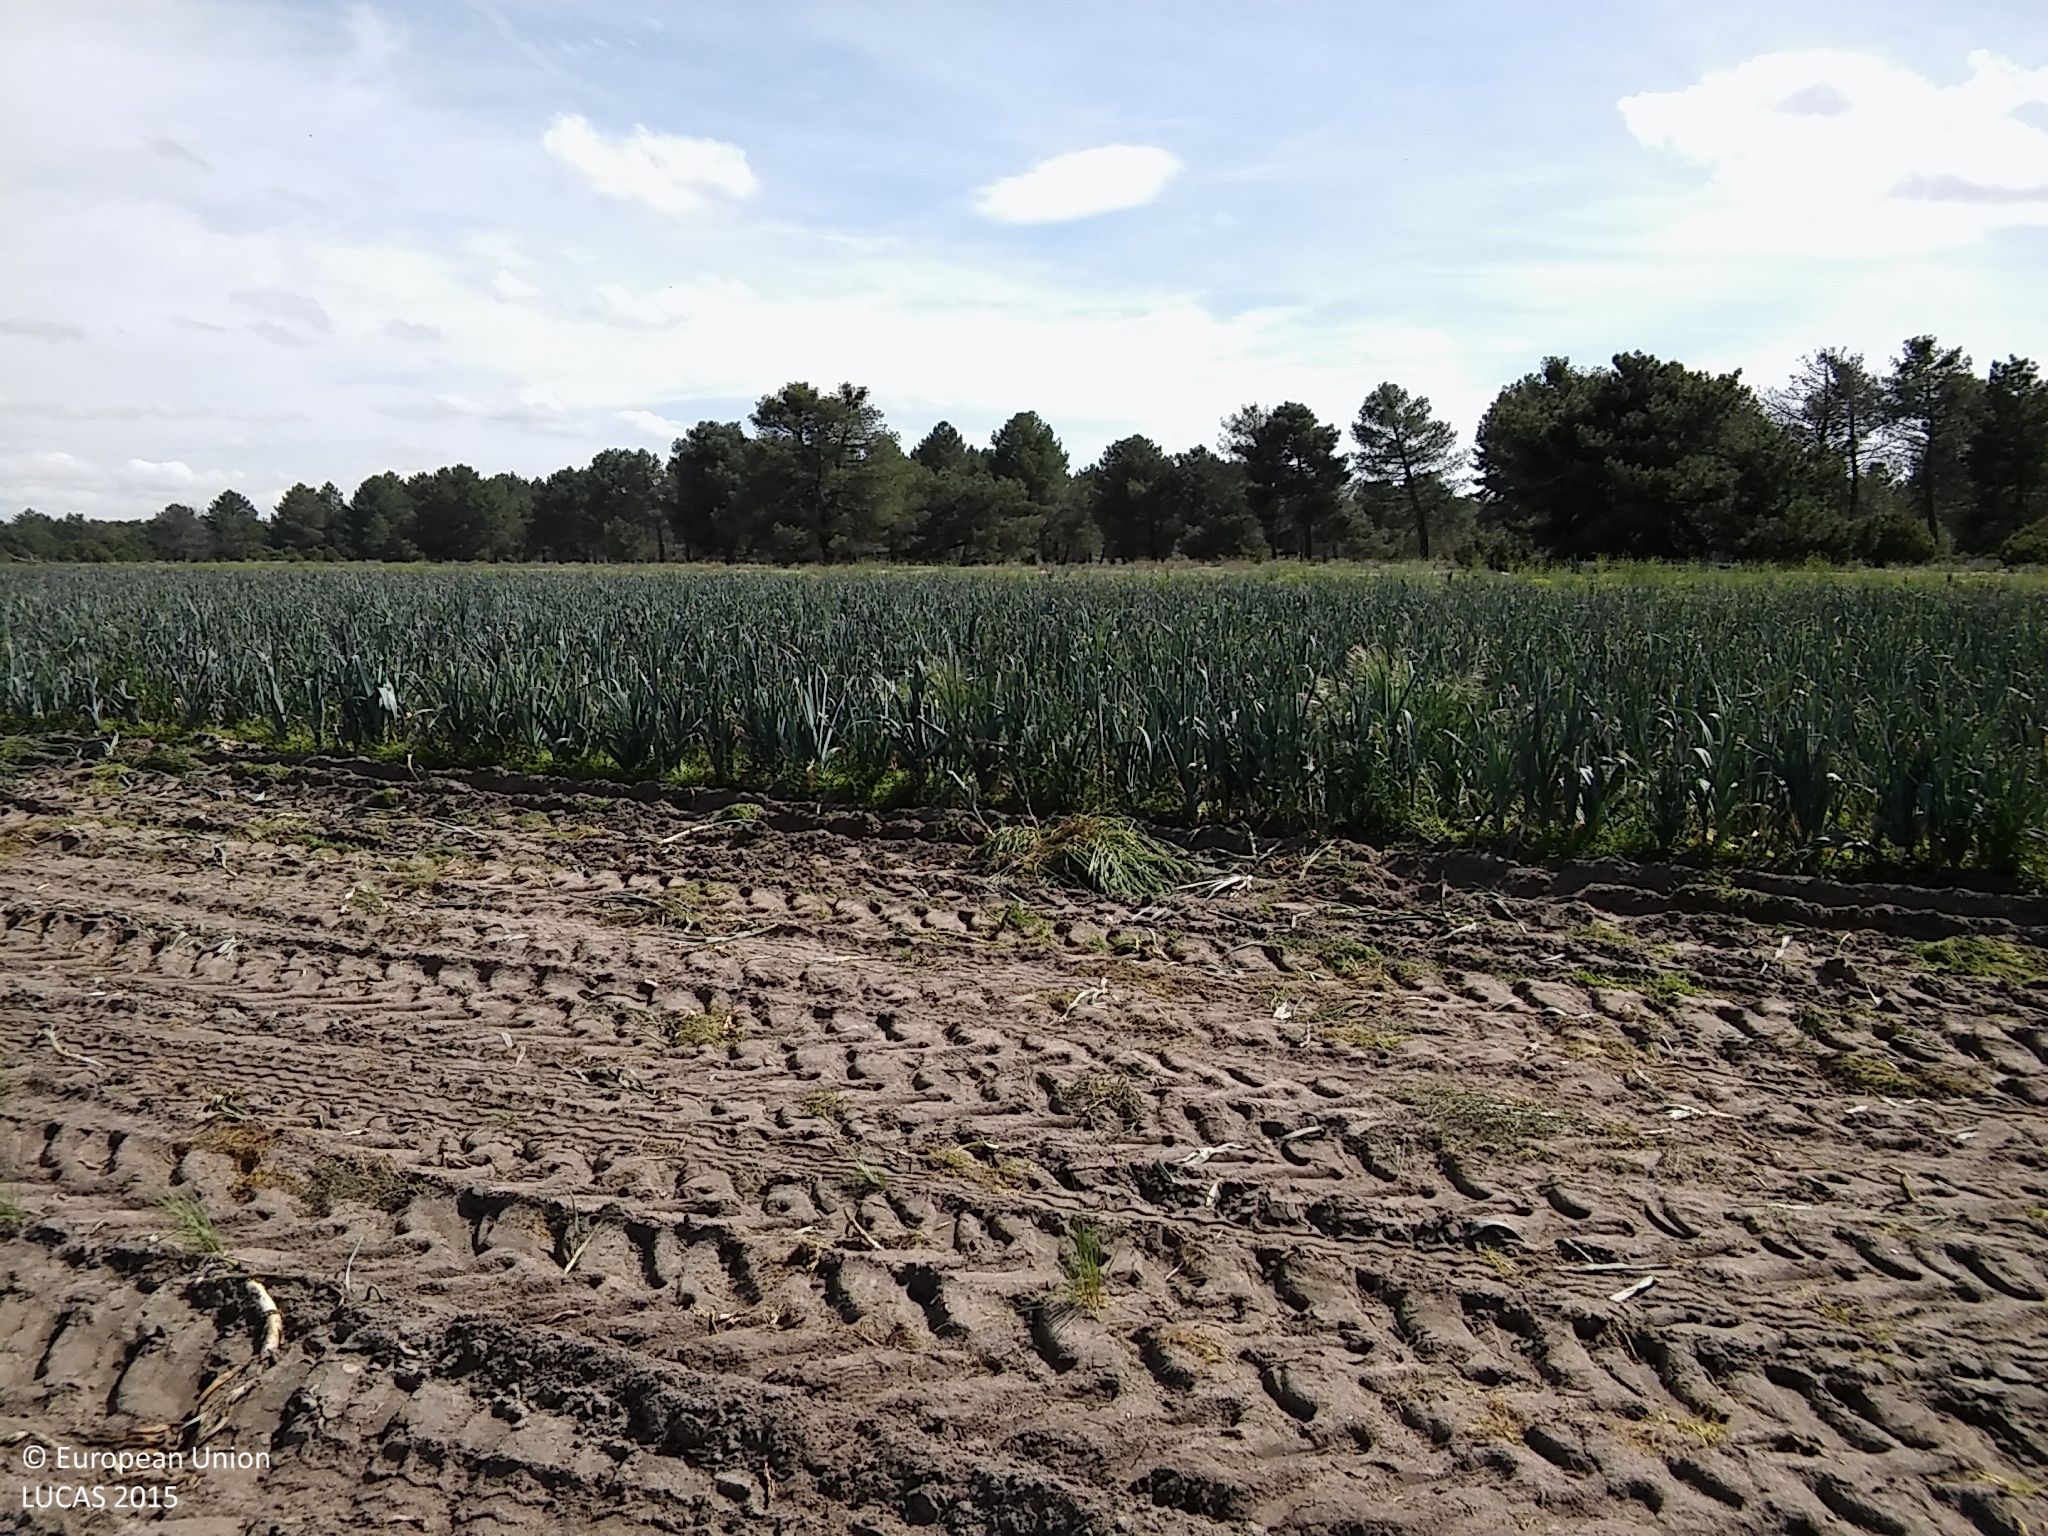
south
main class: Cropland
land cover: Other fresh vegetables
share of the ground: < 10 %
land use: Agriculture (excluding fallow land and kitchen gardens)
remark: Harvested field
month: April
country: ES
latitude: 41.3088
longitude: -4.1376
